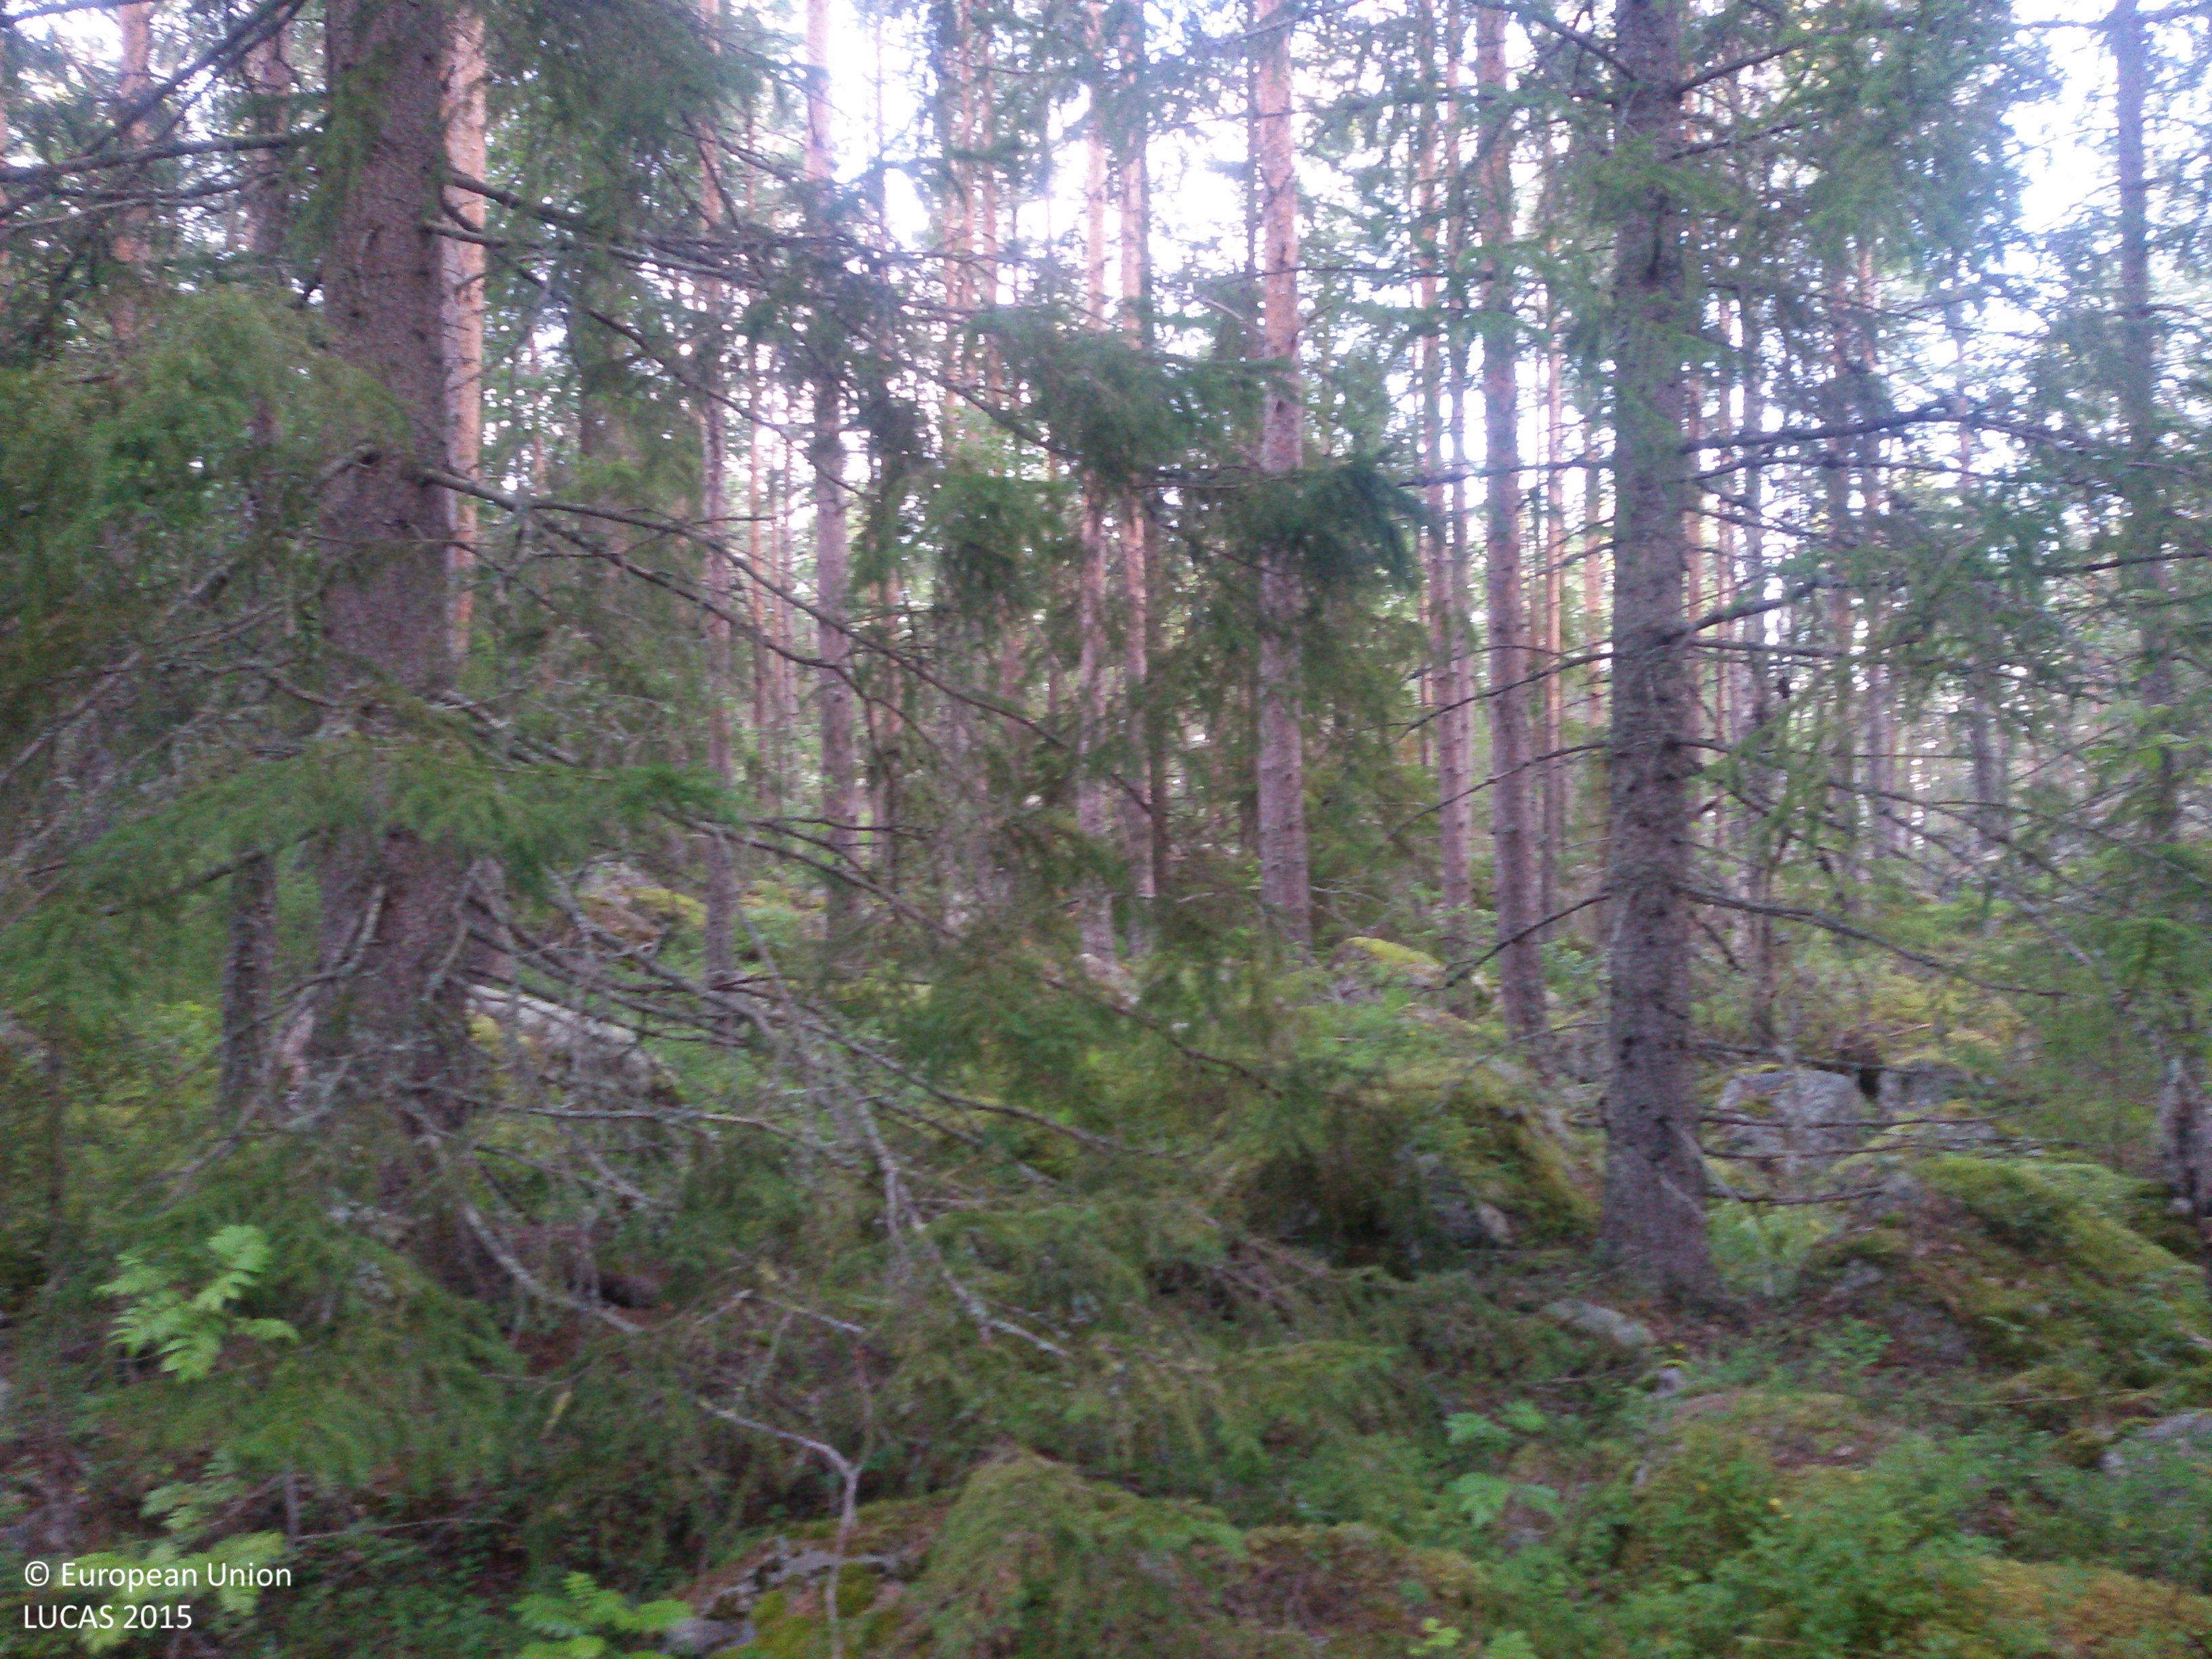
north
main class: Woodland
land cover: Pine dominated coniferous woodland
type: boreal forest
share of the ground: > 75 %
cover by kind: coniferous forest trees 80 %, shrubs 10 %, lichens and mosses 10 %
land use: Forestry
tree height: > 5 m
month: August
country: SE
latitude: 60.5403
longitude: 16.4228
